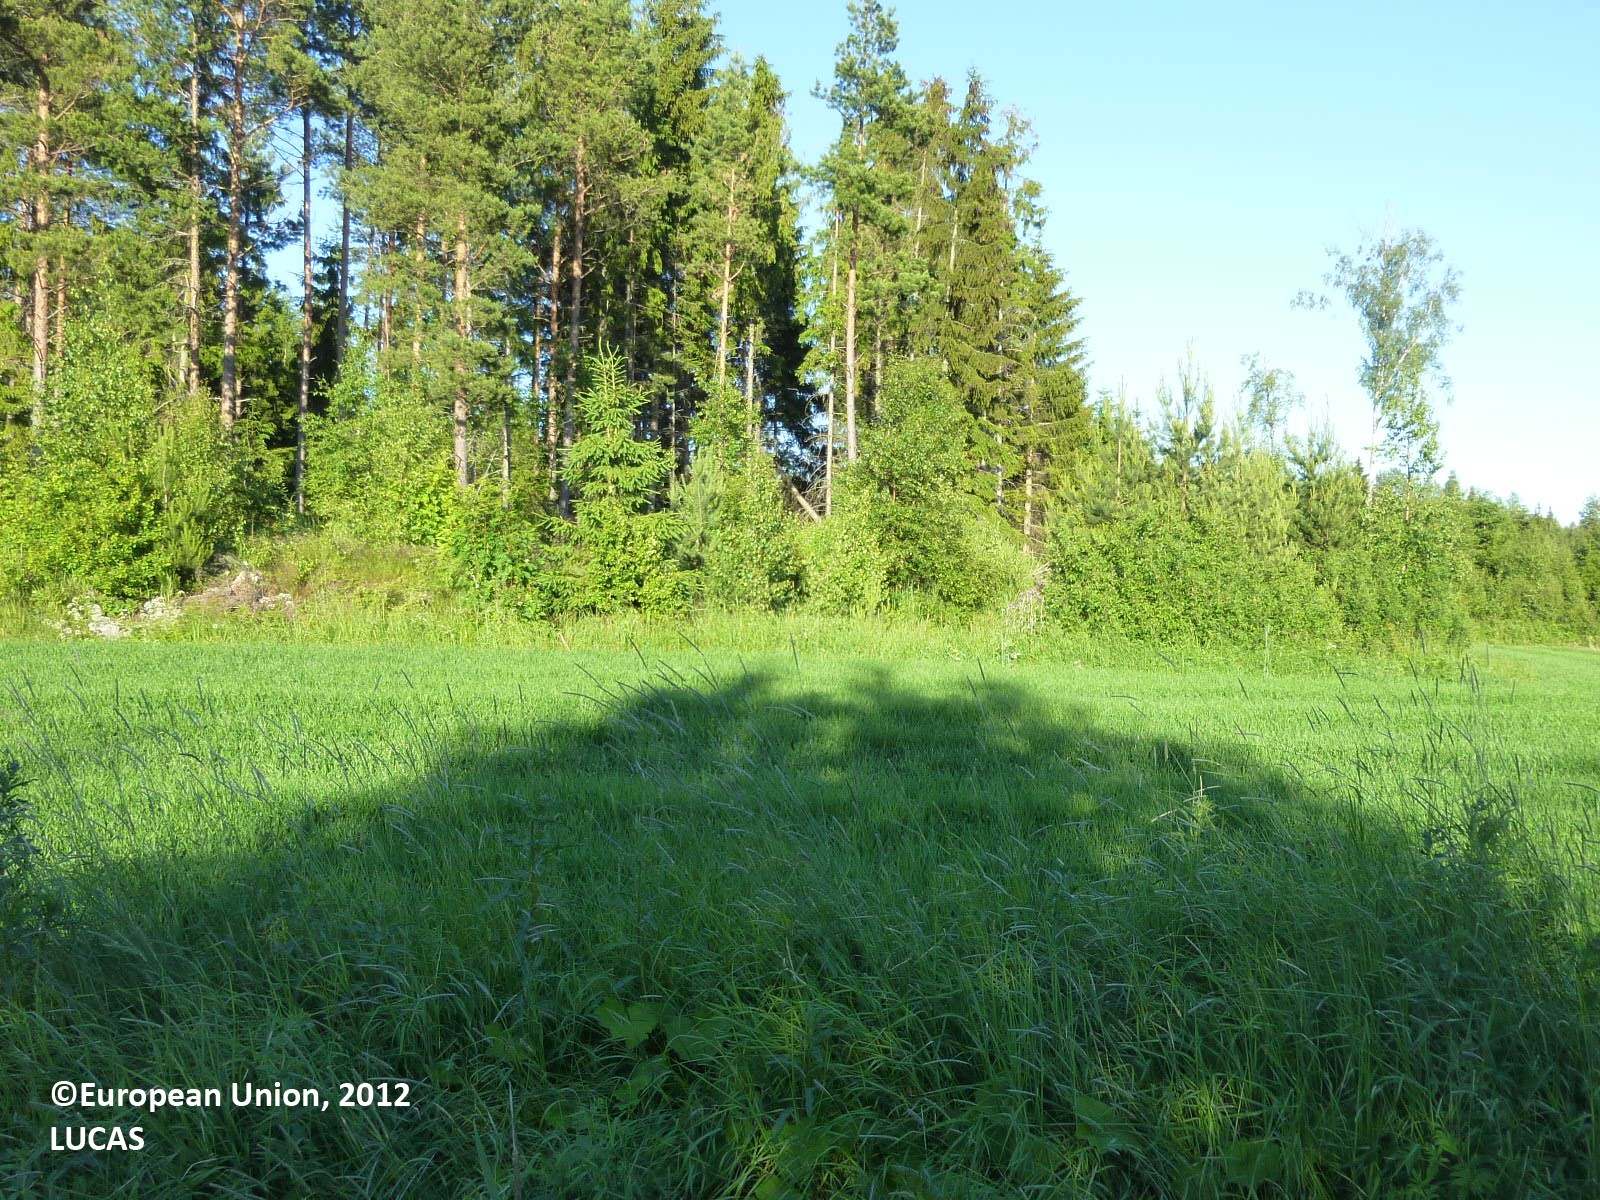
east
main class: Cropland
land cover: Oats
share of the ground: > 75 %
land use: Agriculture (excluding fallow land and kitchen gardens)
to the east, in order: Oats; Ditches and canals; Pine dominated coniferous woodland
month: June
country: FI
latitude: 60.0854
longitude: 22.4215
